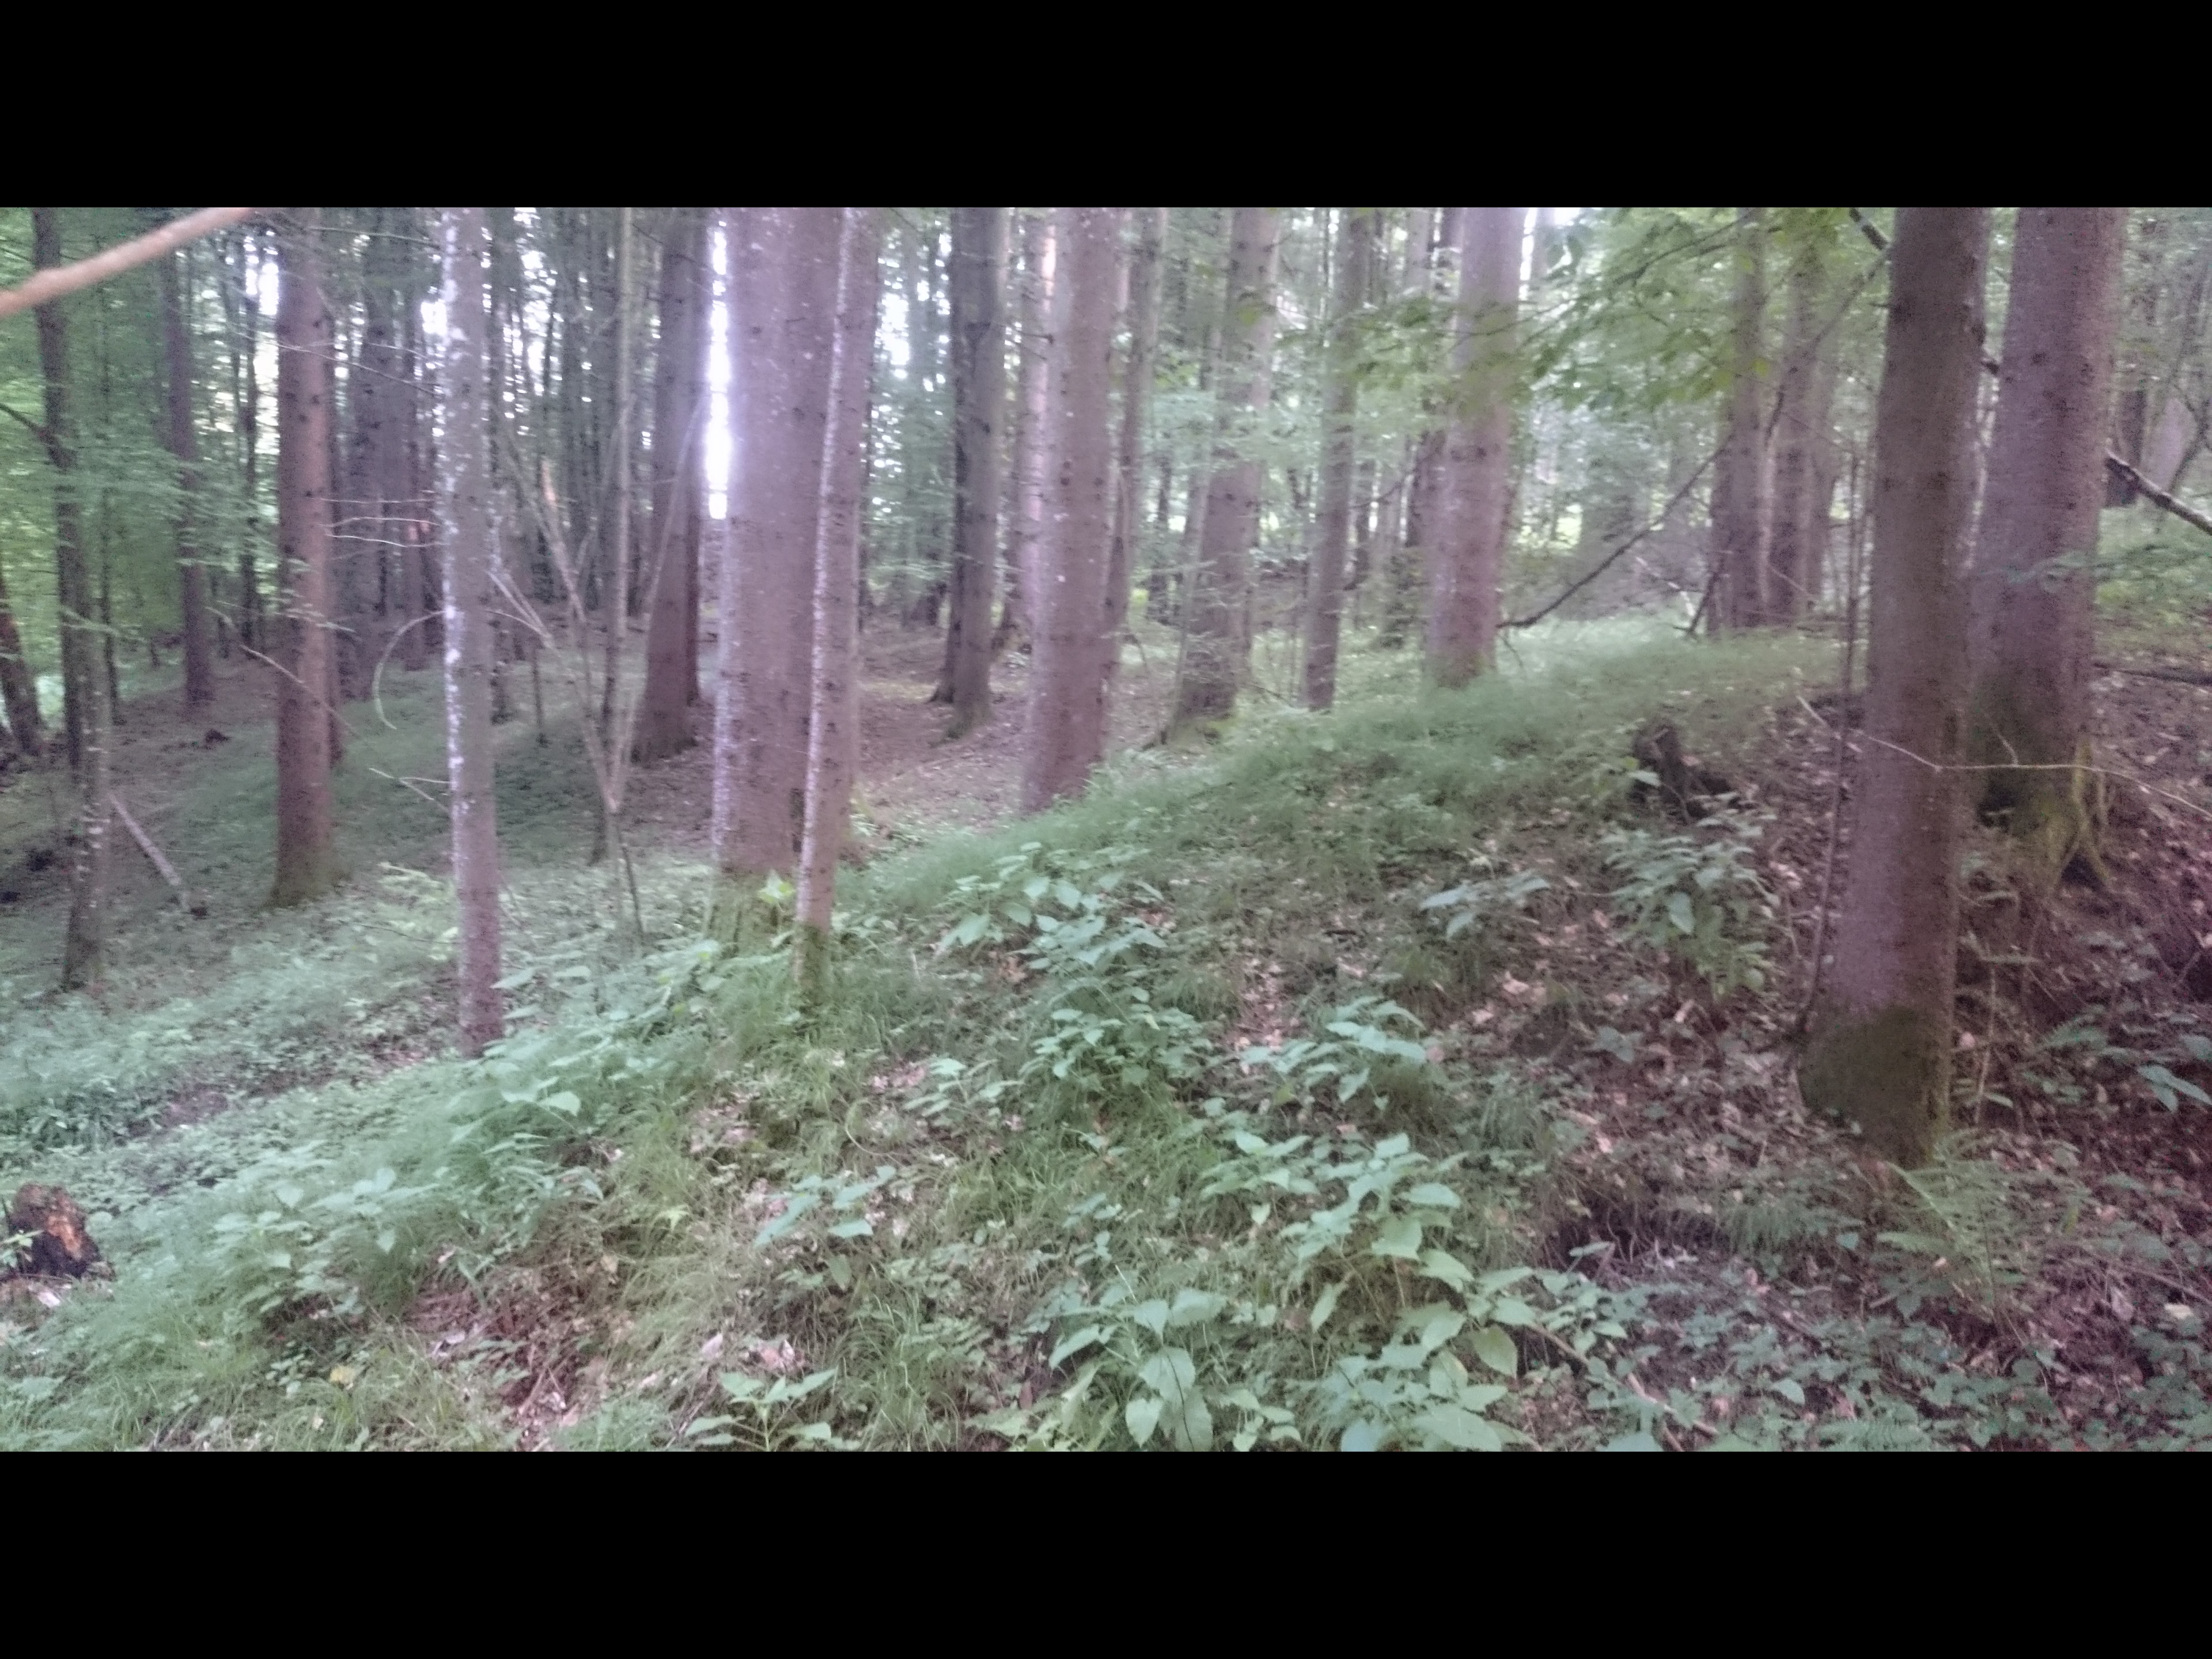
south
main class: Woodland
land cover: Spruce dominated mixed woodland
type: hemiboreal forest and nemoral coniferous forest and mixed broadleaved-coniferous forest
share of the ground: > 75 %
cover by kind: coniferous forest trees 45 %, broadleaved forest trees 45 %, herbaceous plants 10 %
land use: Forestry
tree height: > 5 m
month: July
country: AT
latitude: 47.2285
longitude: 15.6932
